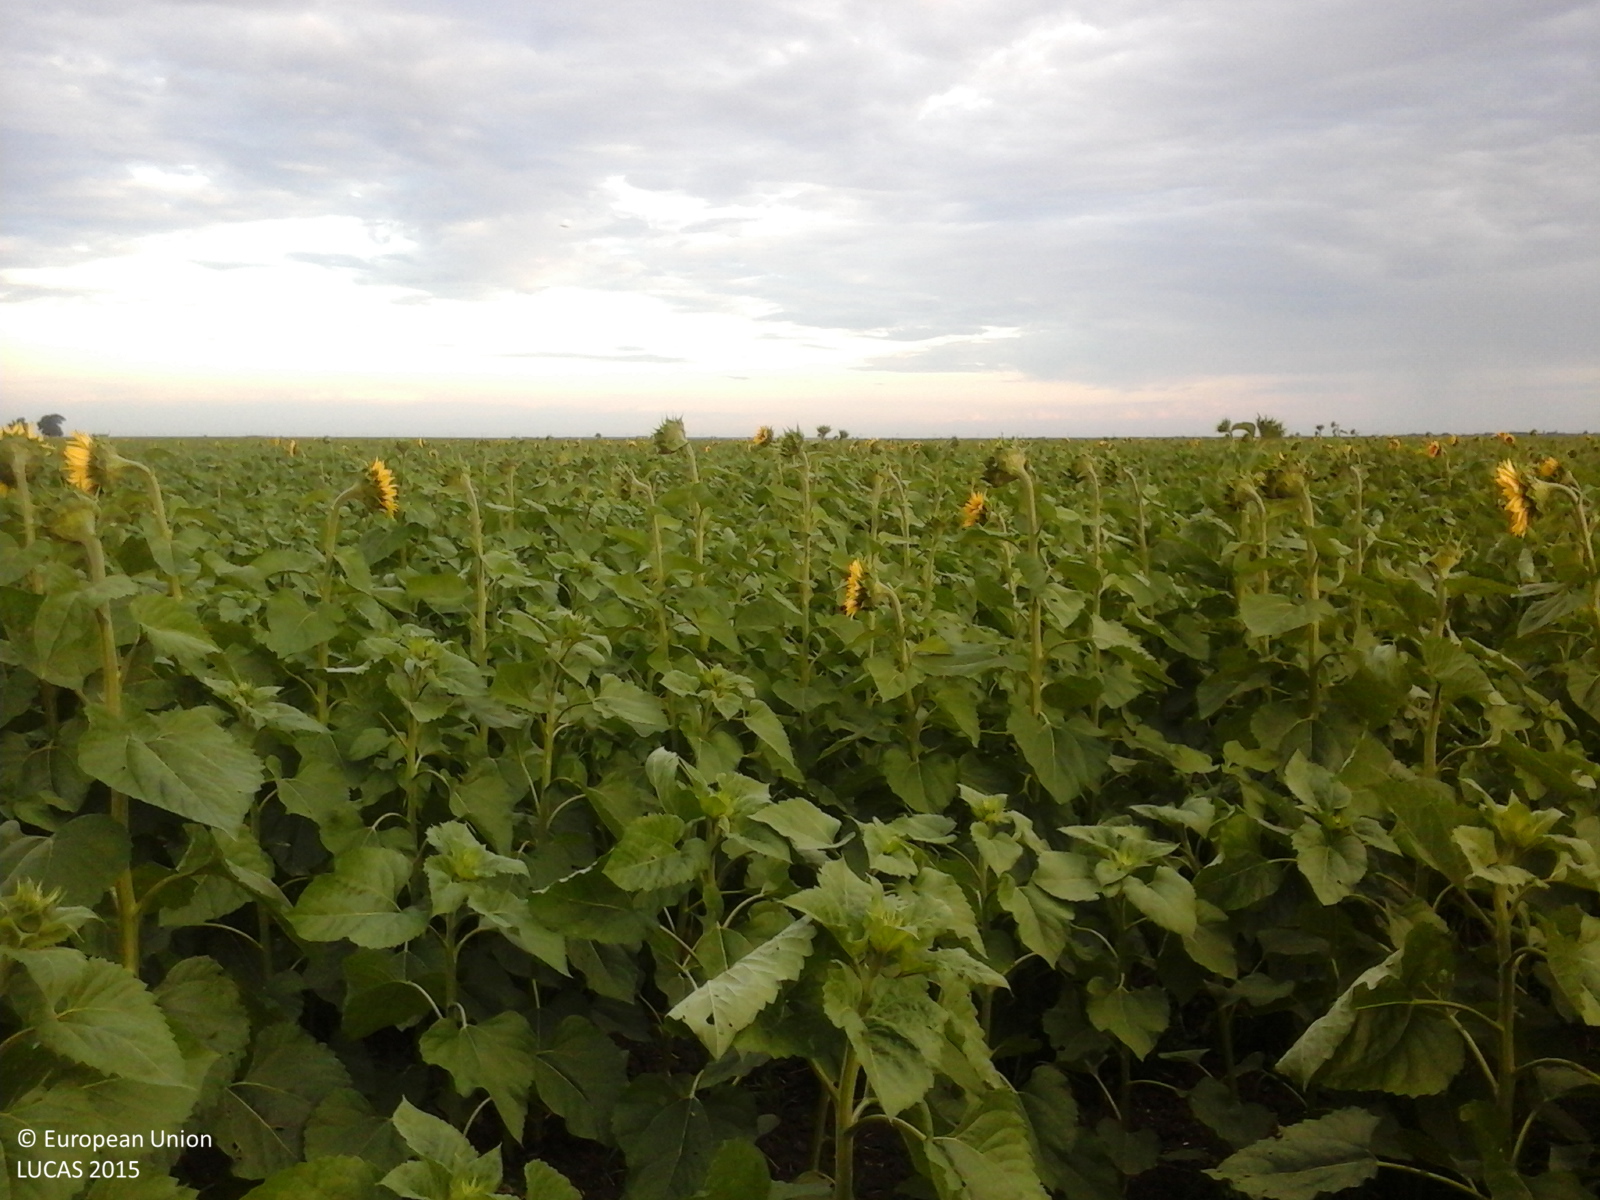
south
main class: Cropland
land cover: Sunflower
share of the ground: > 75 %
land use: Agriculture (excluding fallow land and kitchen gardens)
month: July
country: RO
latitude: 44.1413
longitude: 24.8120
